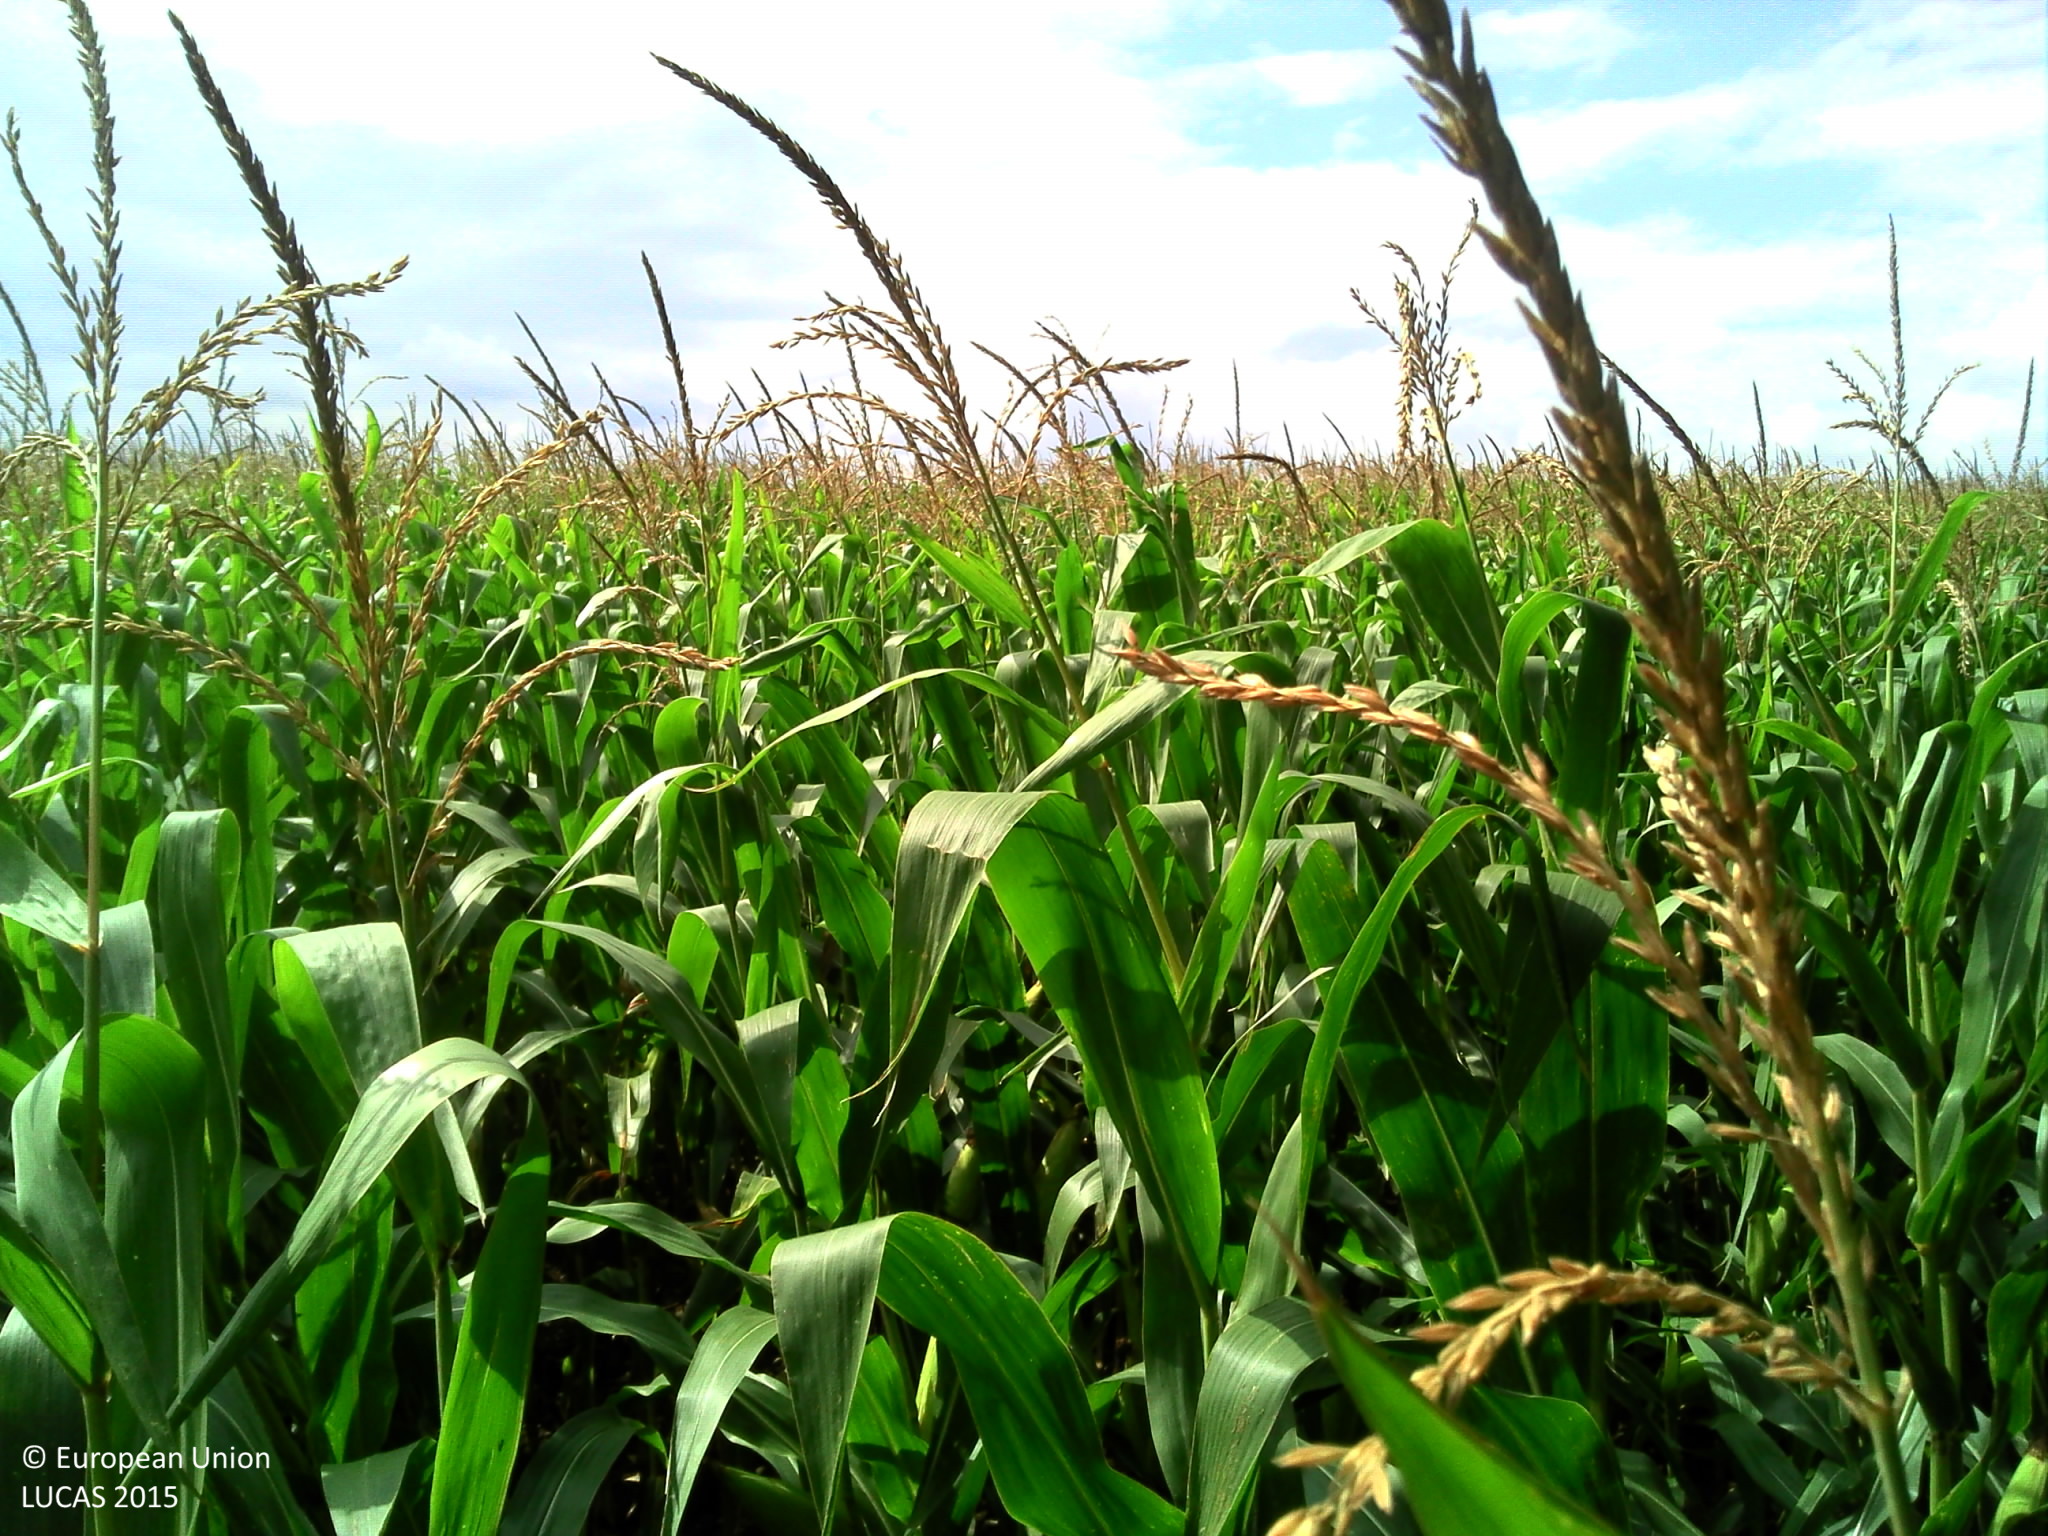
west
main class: Woodland
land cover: Broadleaved woodland
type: mesophytic deciduous forest
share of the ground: > 75 %
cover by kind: broadleaved forest trees 80 %, shrubs 10 %, herbaceous plants 5 %, lichens and mosses 5 %
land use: Forestry
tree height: > 5 m
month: September
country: FR
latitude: 43.4493
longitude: -0.1762
